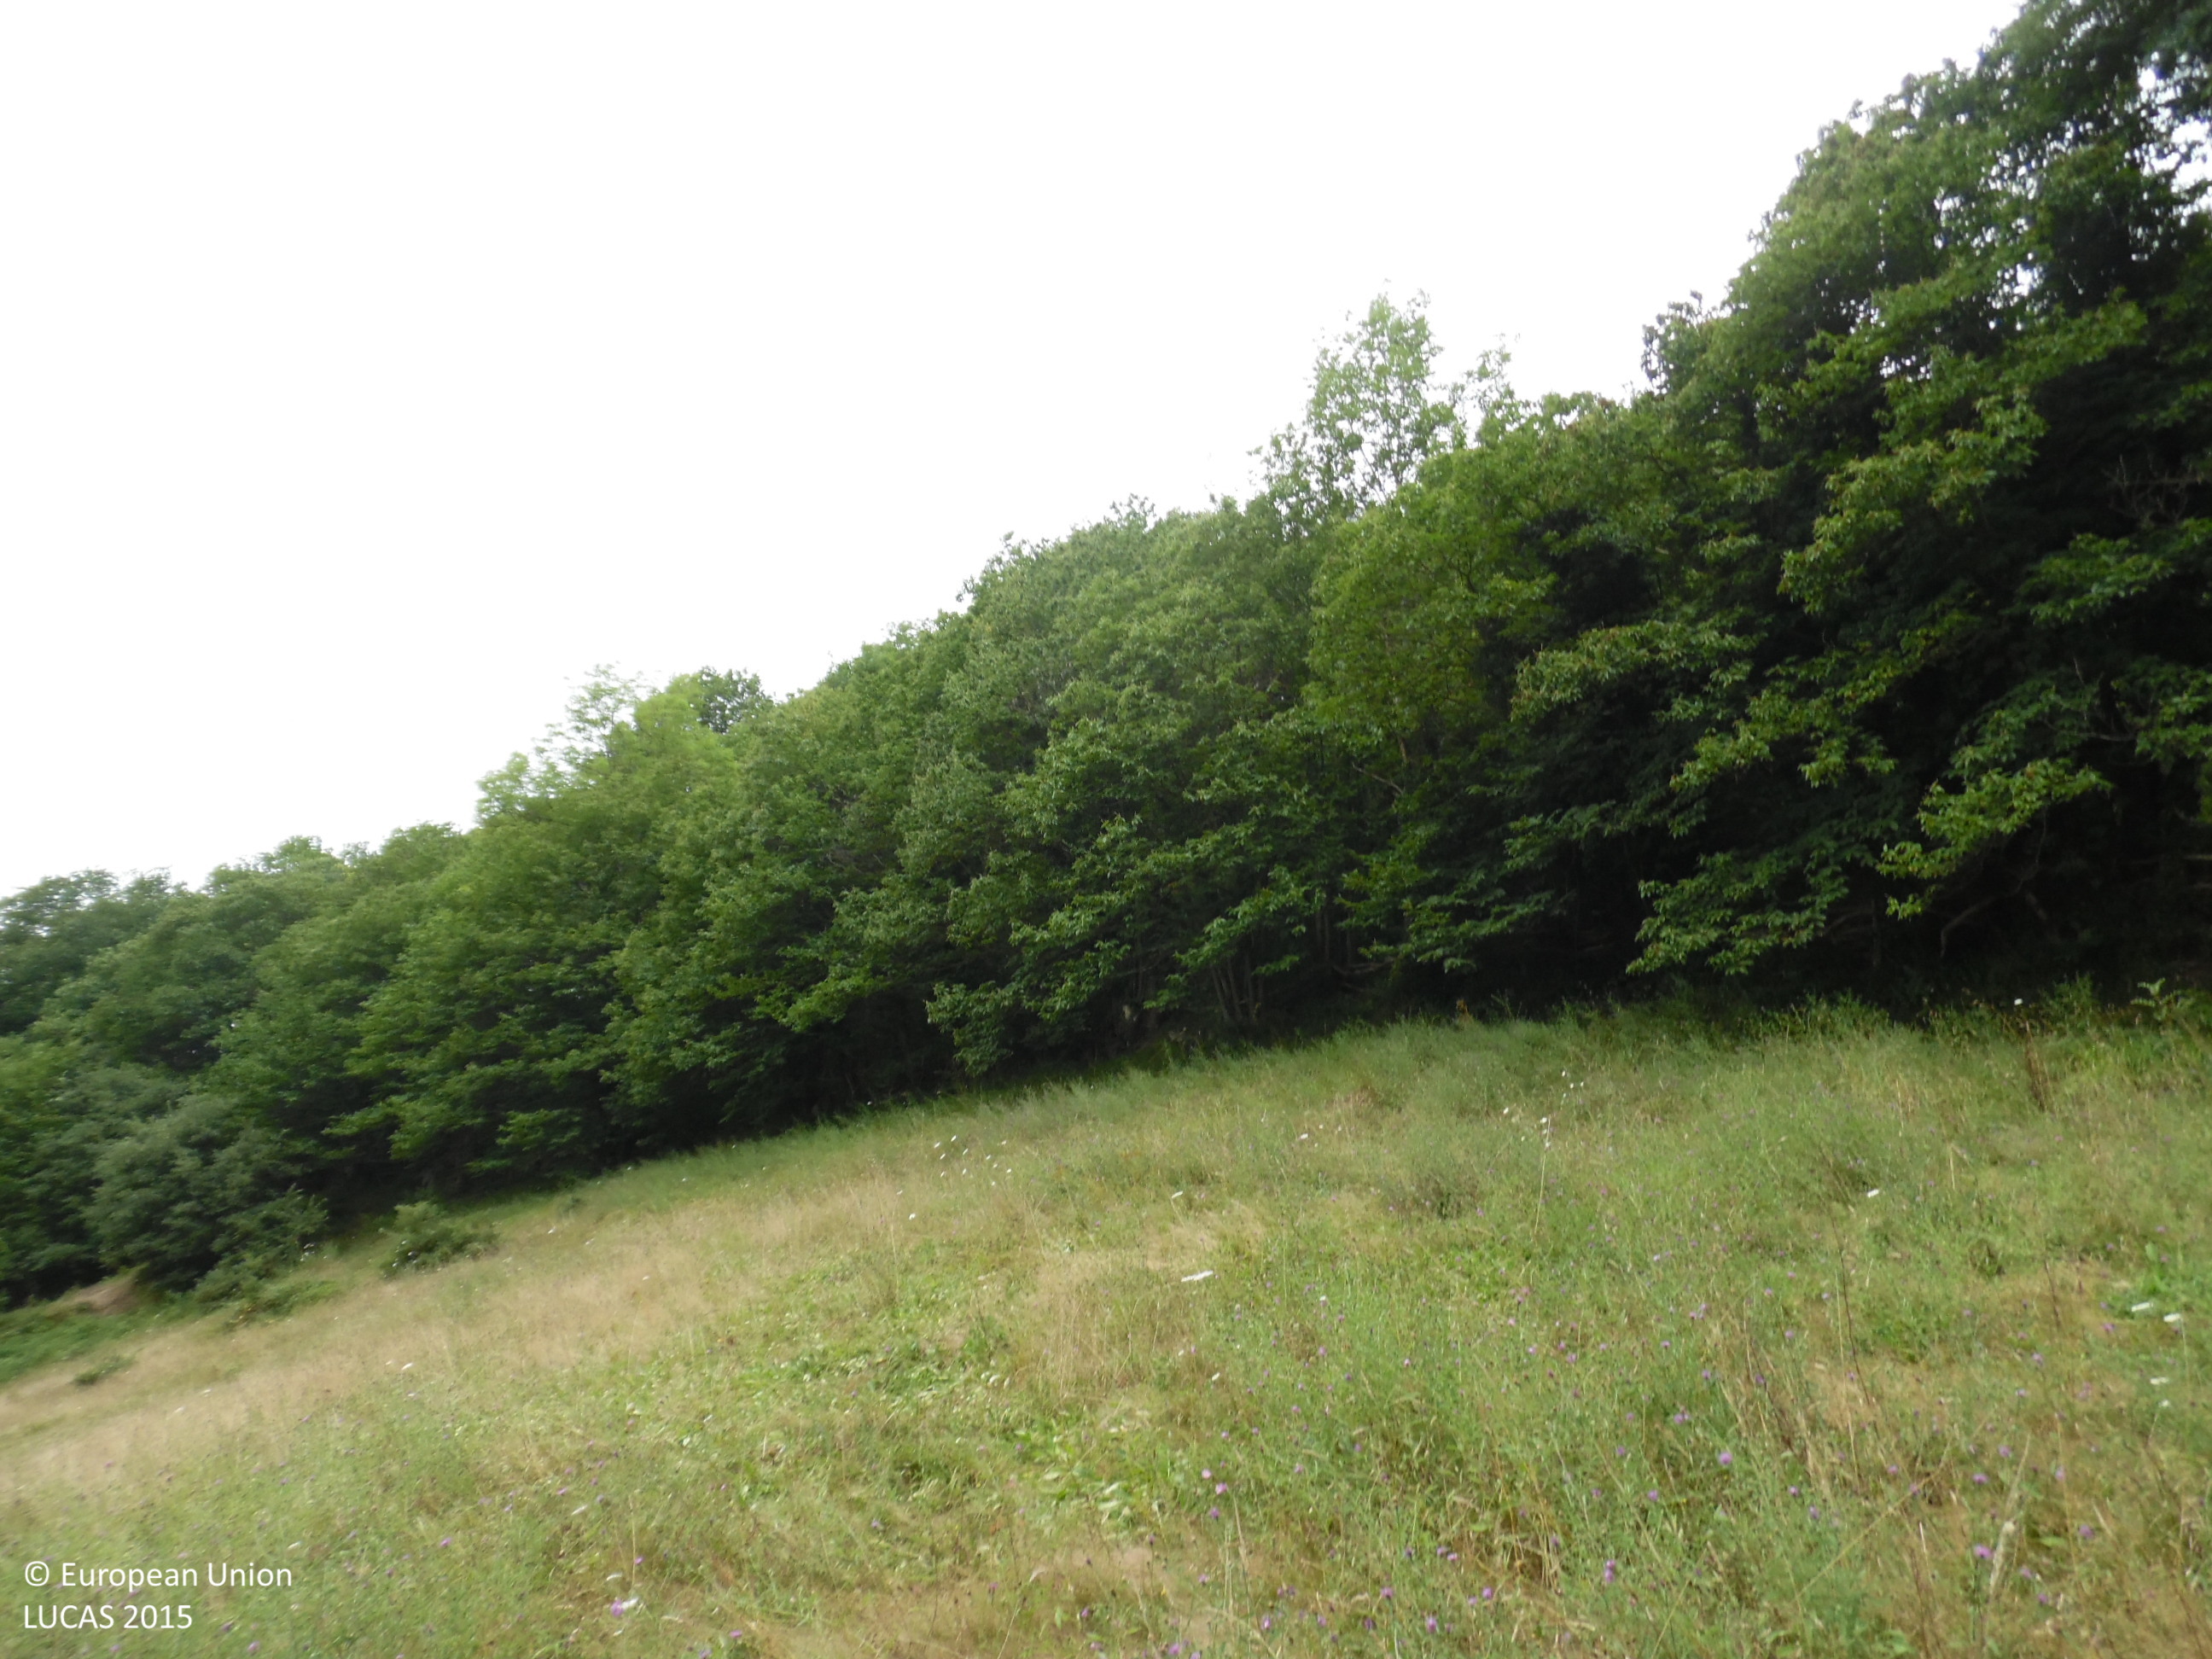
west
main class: Grassland
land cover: Grassland without tree/shrub cover
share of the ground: > 75 %
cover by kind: herbaceous plants 100 %
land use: Agriculture (excluding fallow land and kitchen gardens)
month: July
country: ES
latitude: 43.1599
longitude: -5.9656
